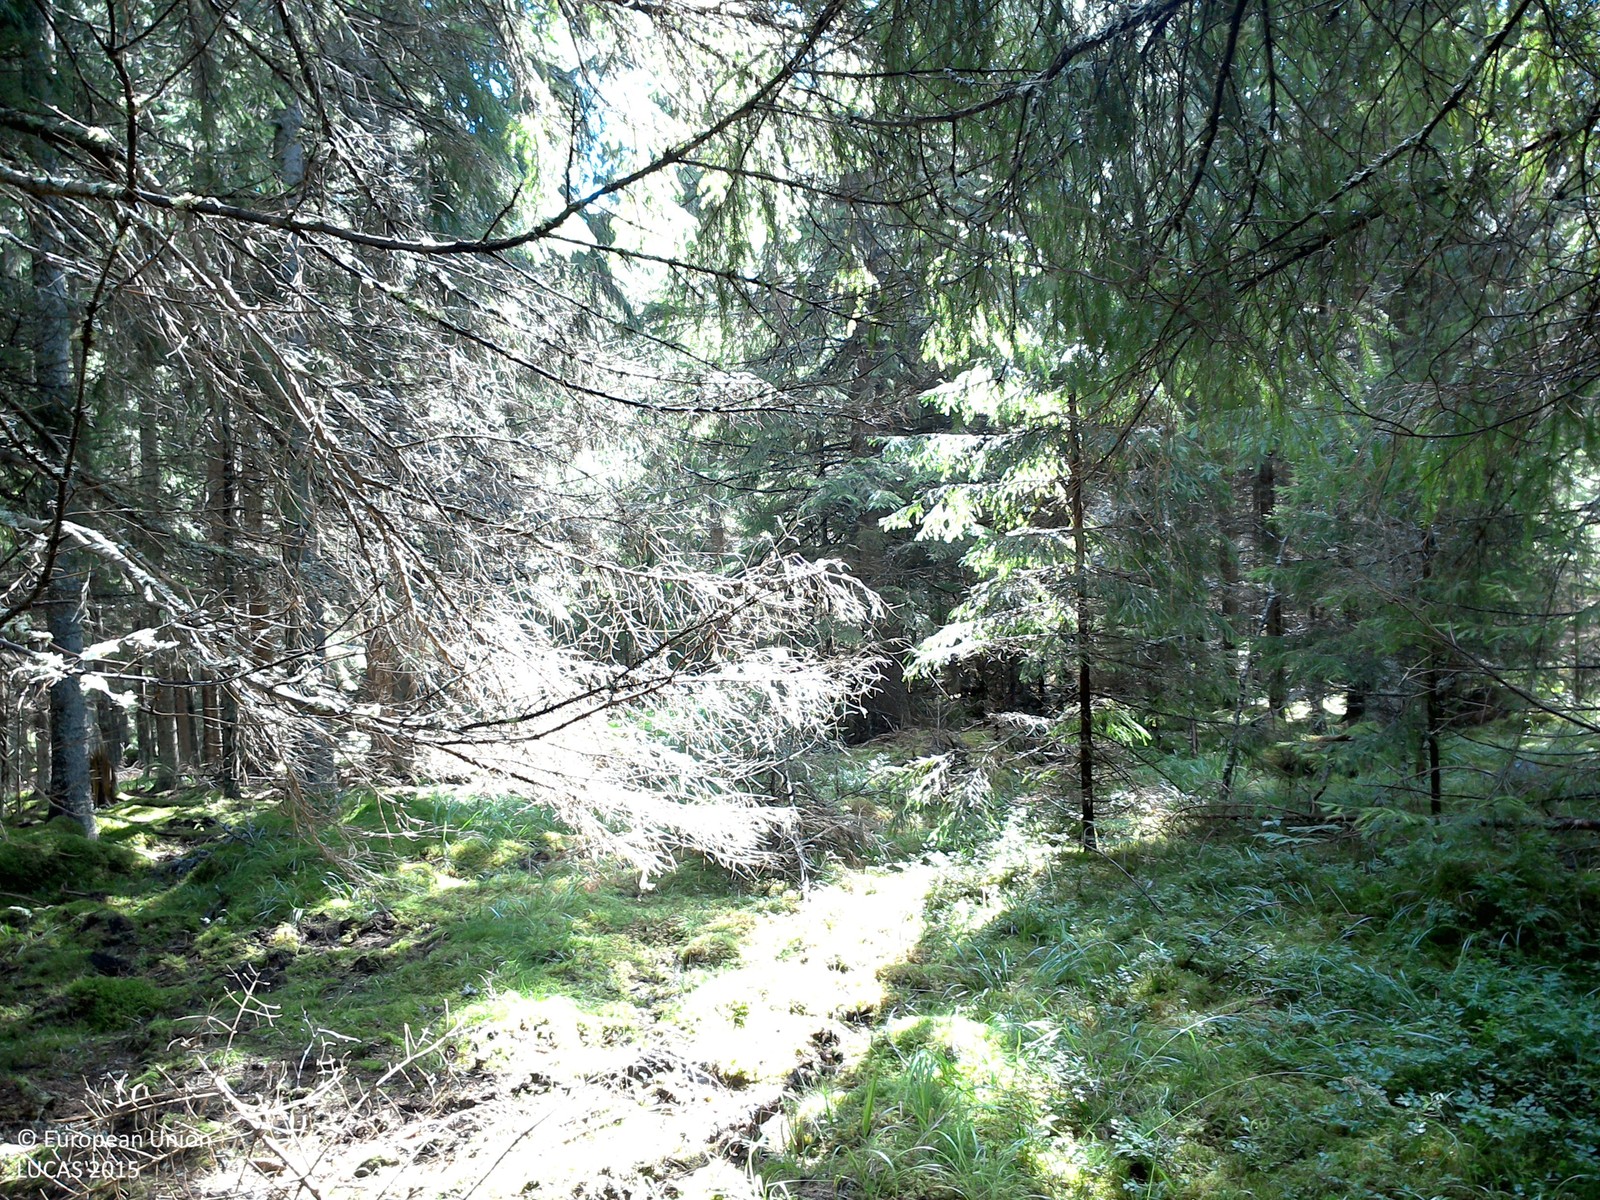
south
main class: Woodland
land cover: Spruce dominated coniferous woodland
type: boreal forest
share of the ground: 50 - 75 %
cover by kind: coniferous forest trees 60 %, lichens and mosses 30 %, herbaceous plants 10 %
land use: Forestry
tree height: > 5 m
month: August
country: SE
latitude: 58.1838
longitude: 15.3859
